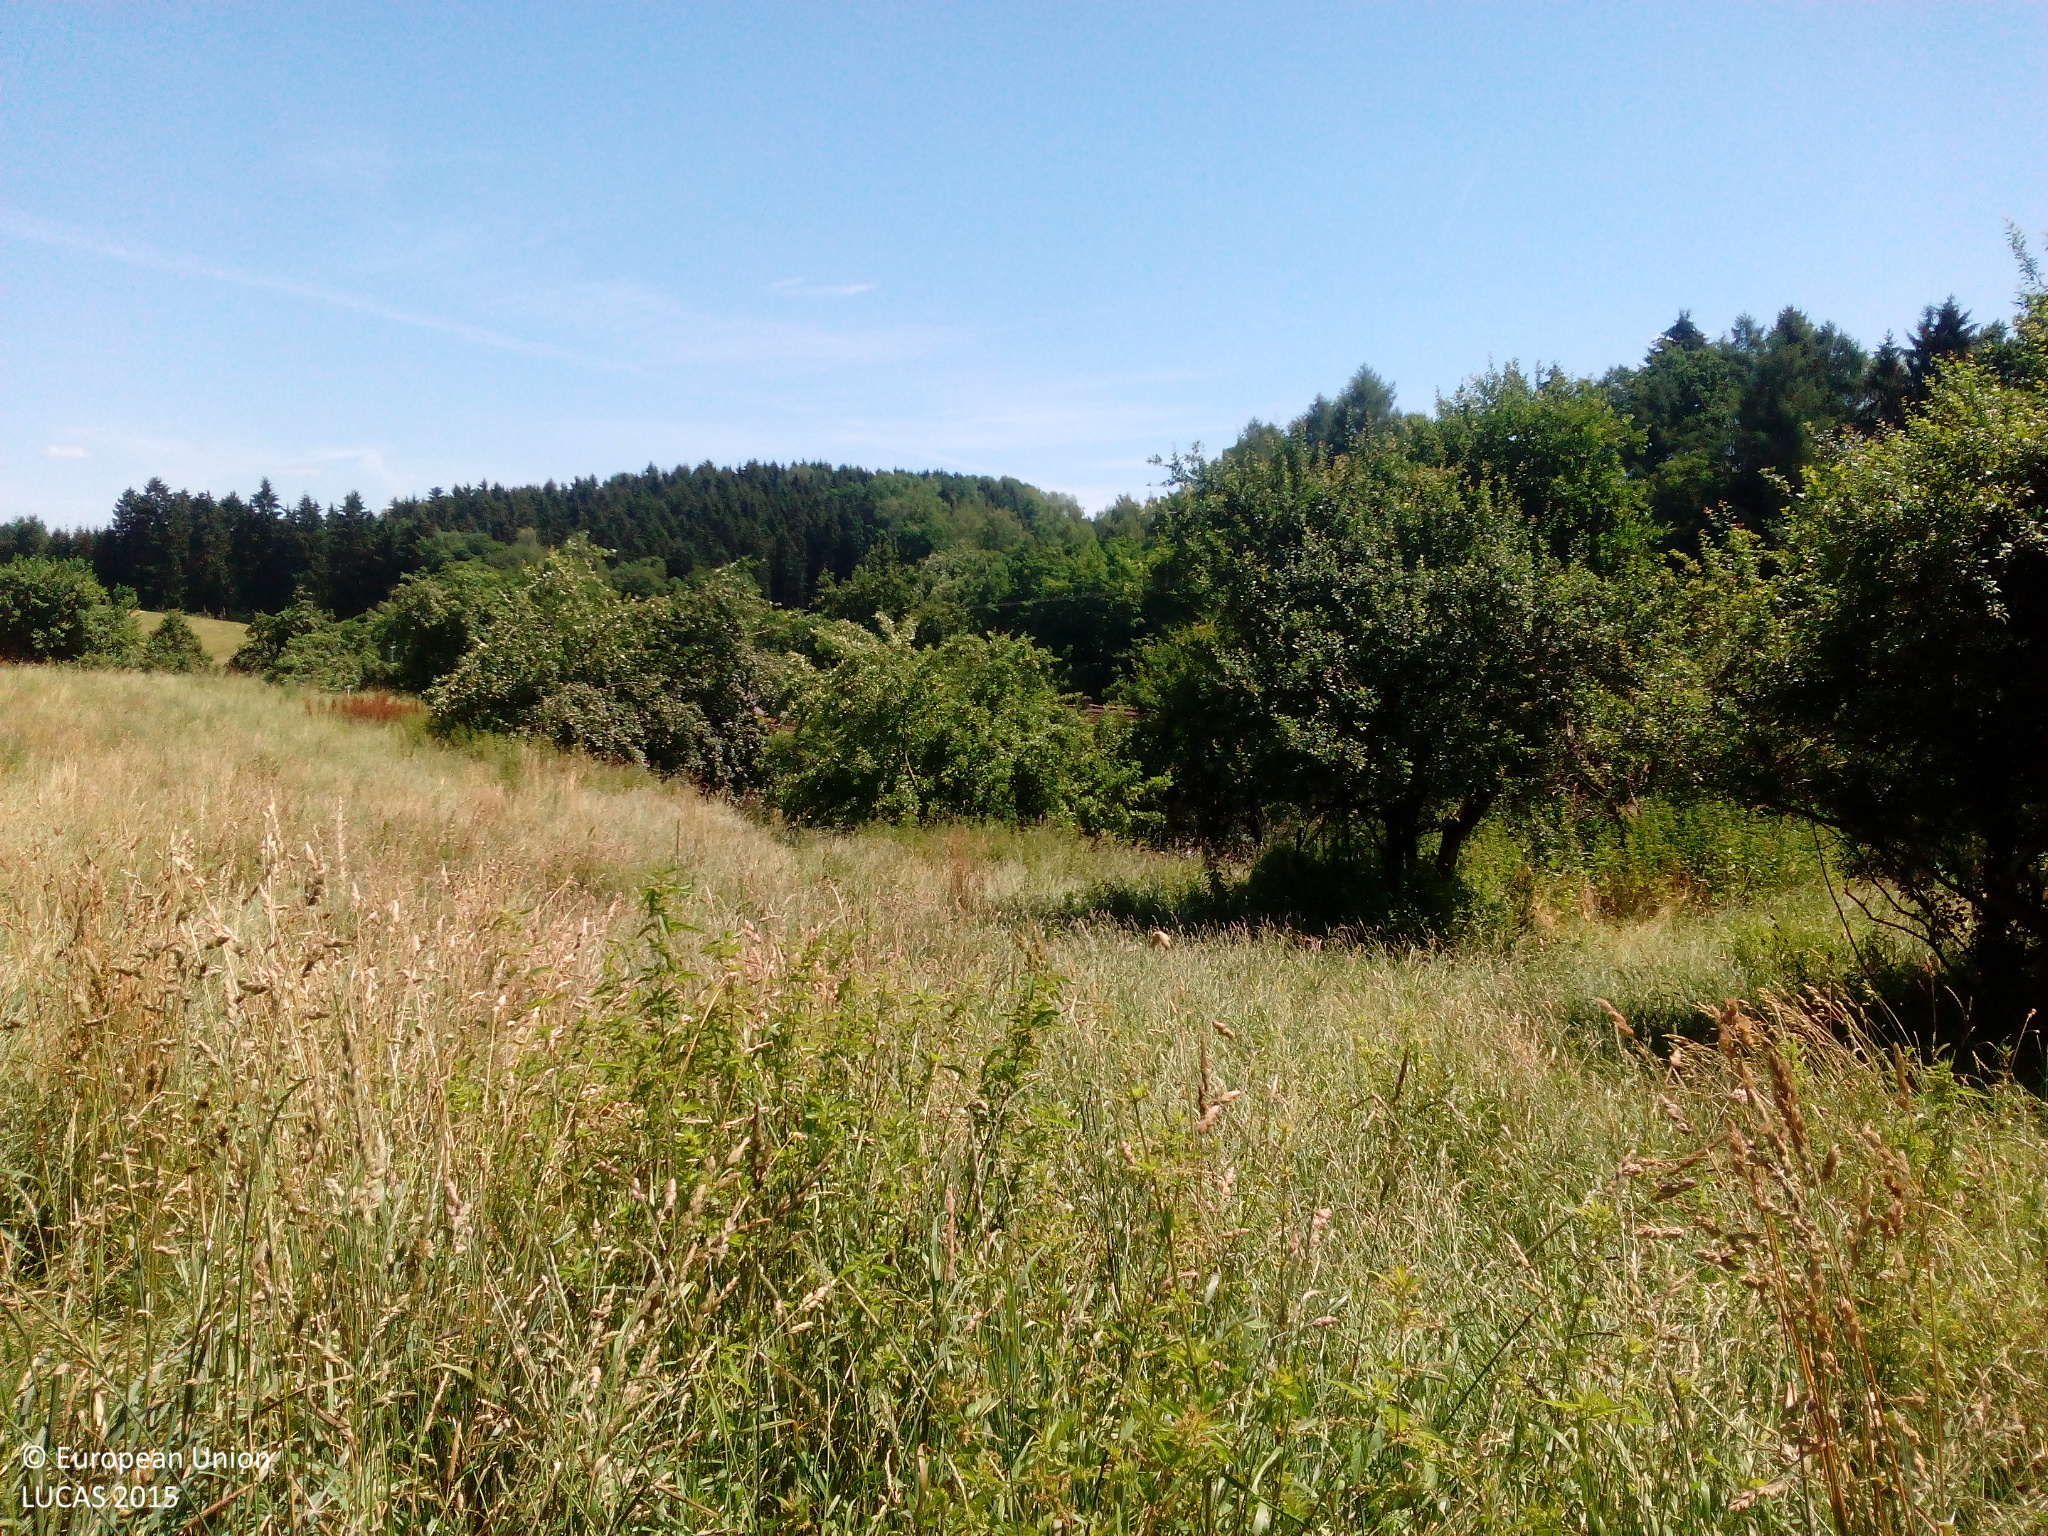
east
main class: Grassland
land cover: Grassland without tree/shrub cover
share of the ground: > 75 %
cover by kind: herbaceous plants 100 %
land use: Agriculture (excluding fallow land and kitchen gardens)
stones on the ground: < 10 %
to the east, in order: Grassland without tree/shrub cover; Apple fruit; Grassland without tree/shrub cover; Fences; Artificial constructions in urban areas; Single bushes/trees; Paved roads, cycling and walking lanes; Electric lines; Fences; Grassland without tree/shrub cover; Electric lines; Grassland without tree/shrub cover; Broadleaved woodland; Inland fresh running water; Broadleaved woodland; Tracks
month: July
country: DE
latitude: 49.7671
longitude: 12.2071
